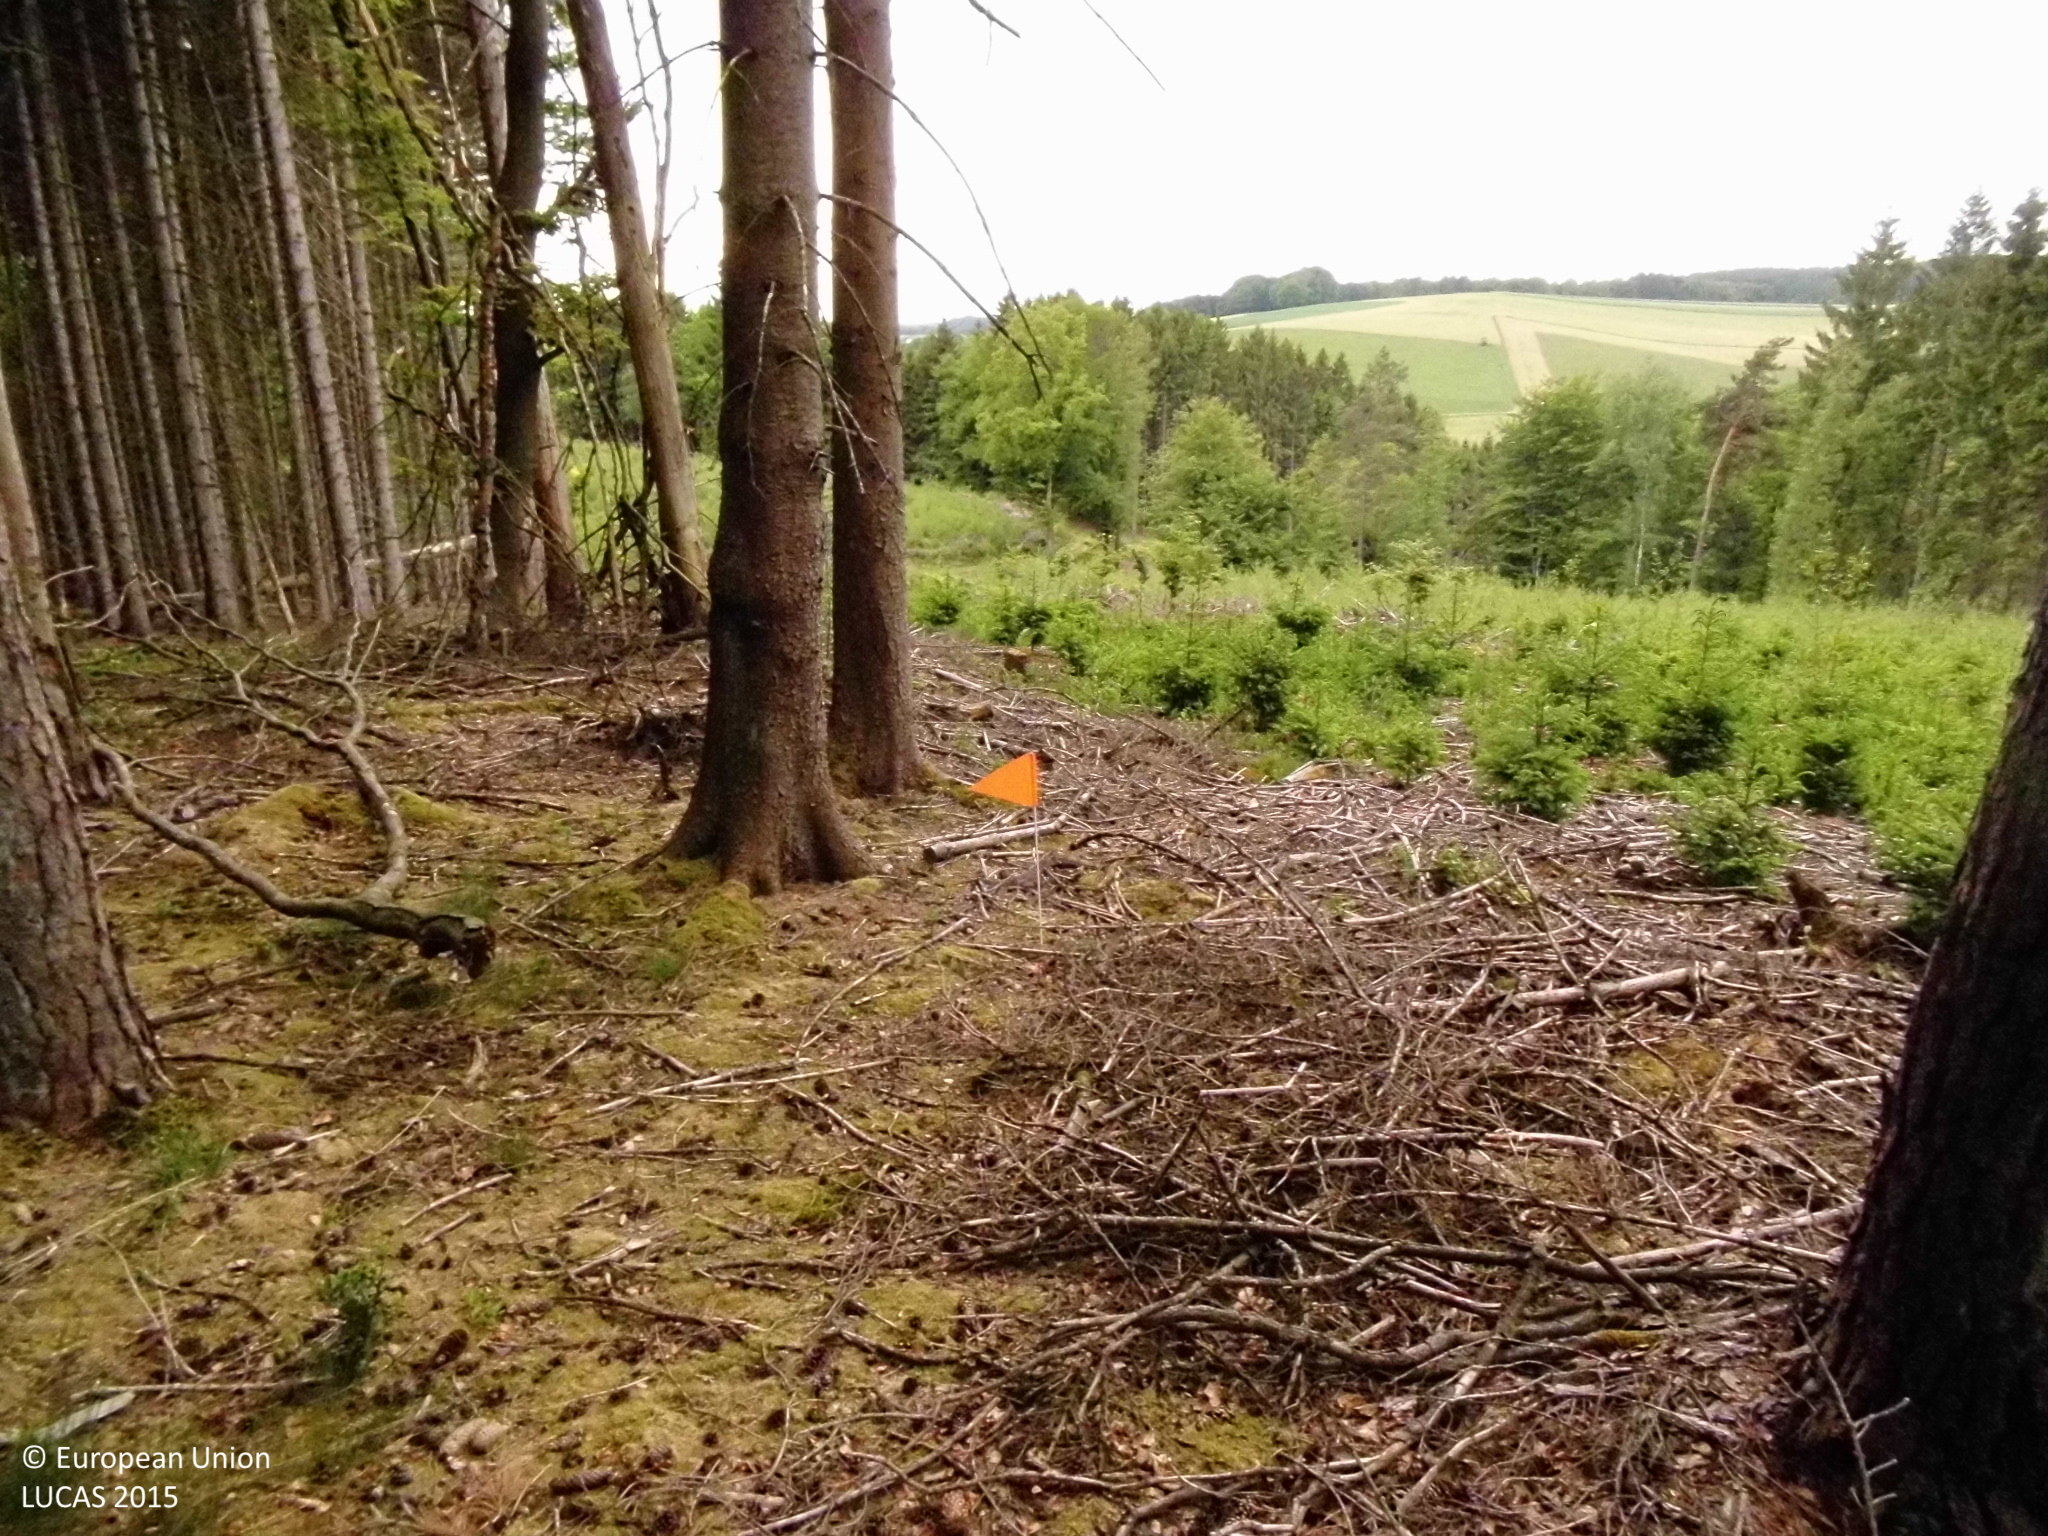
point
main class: Woodland
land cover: Other mixed woodland
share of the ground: > 75 %
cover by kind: coniferous forest trees 40 %, broadleaved forest trees 40 %, lichens and mosses 10 %, herbaceous plants 5 %, unconsolidated bare surface 5 %
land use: Forestry
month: May
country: DE
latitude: 50.9120
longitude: 7.4828
